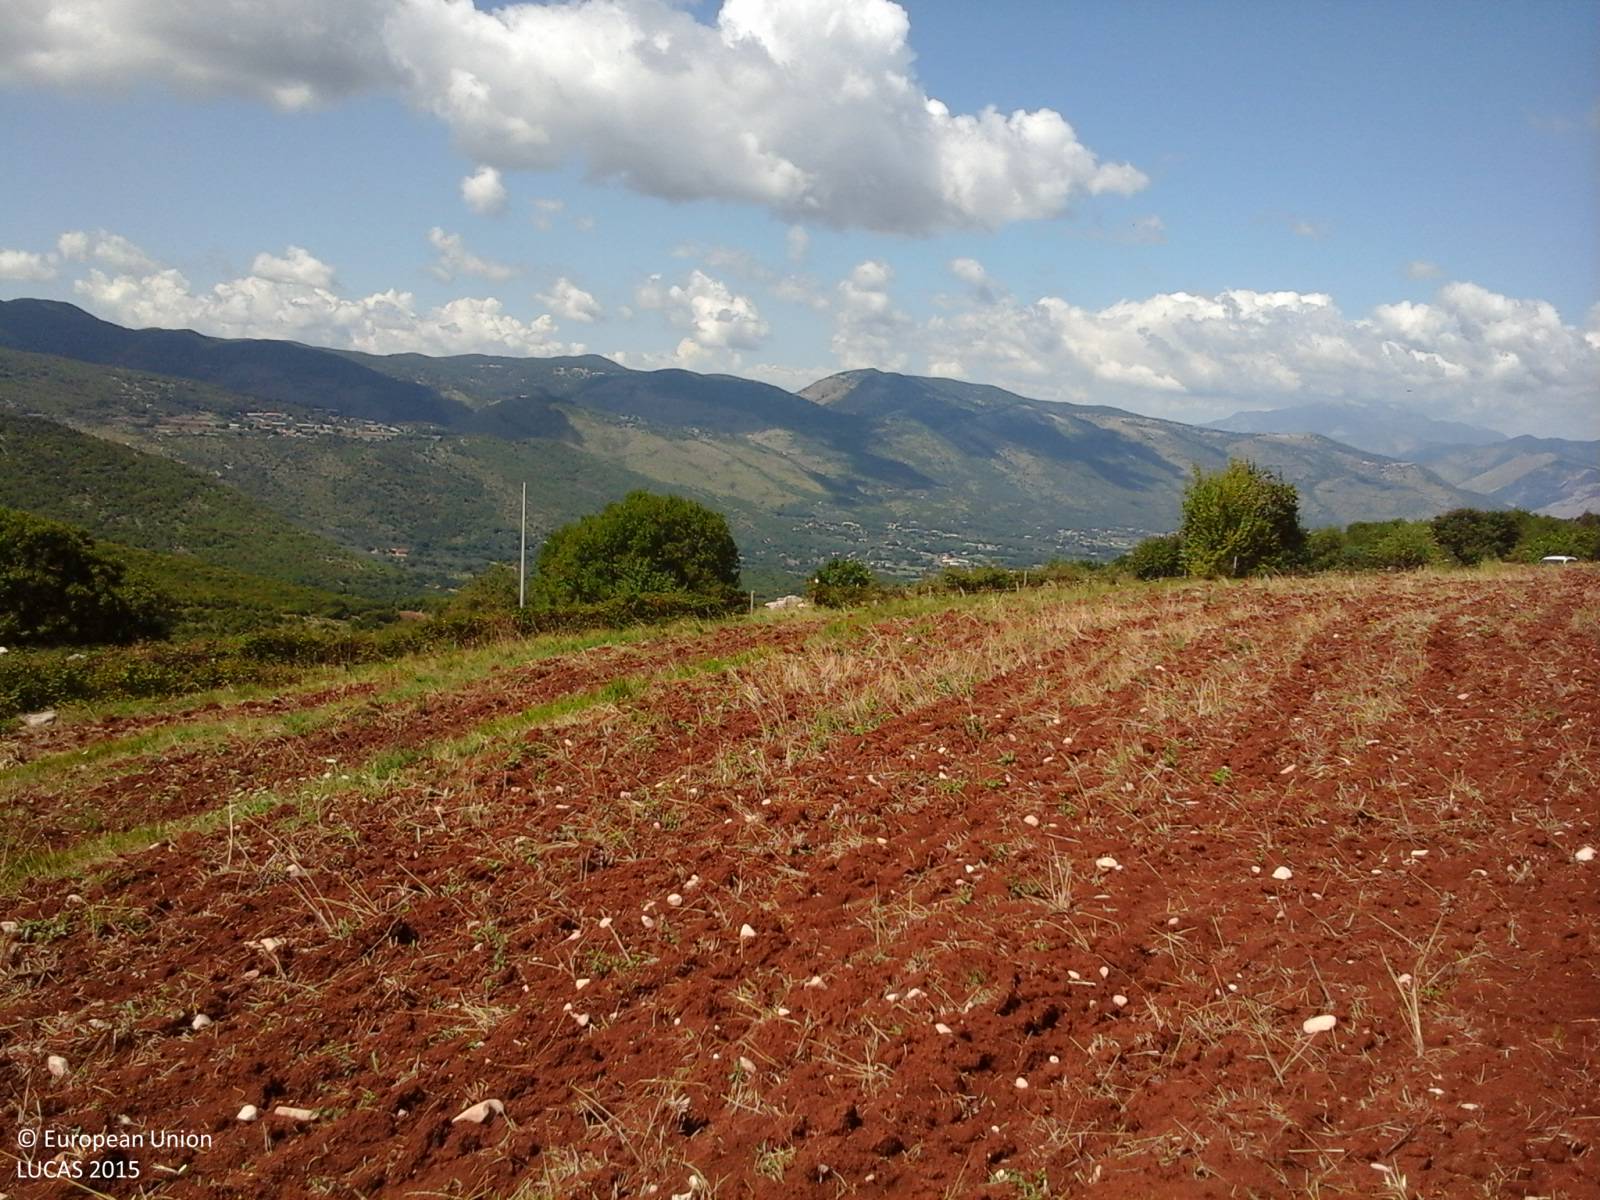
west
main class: Cropland
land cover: Temporary grasslands
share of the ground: < 10 %
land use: Agriculture (excluding fallow land and kitchen gardens)
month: August
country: IT
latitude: 41.4404
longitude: 13.3739
